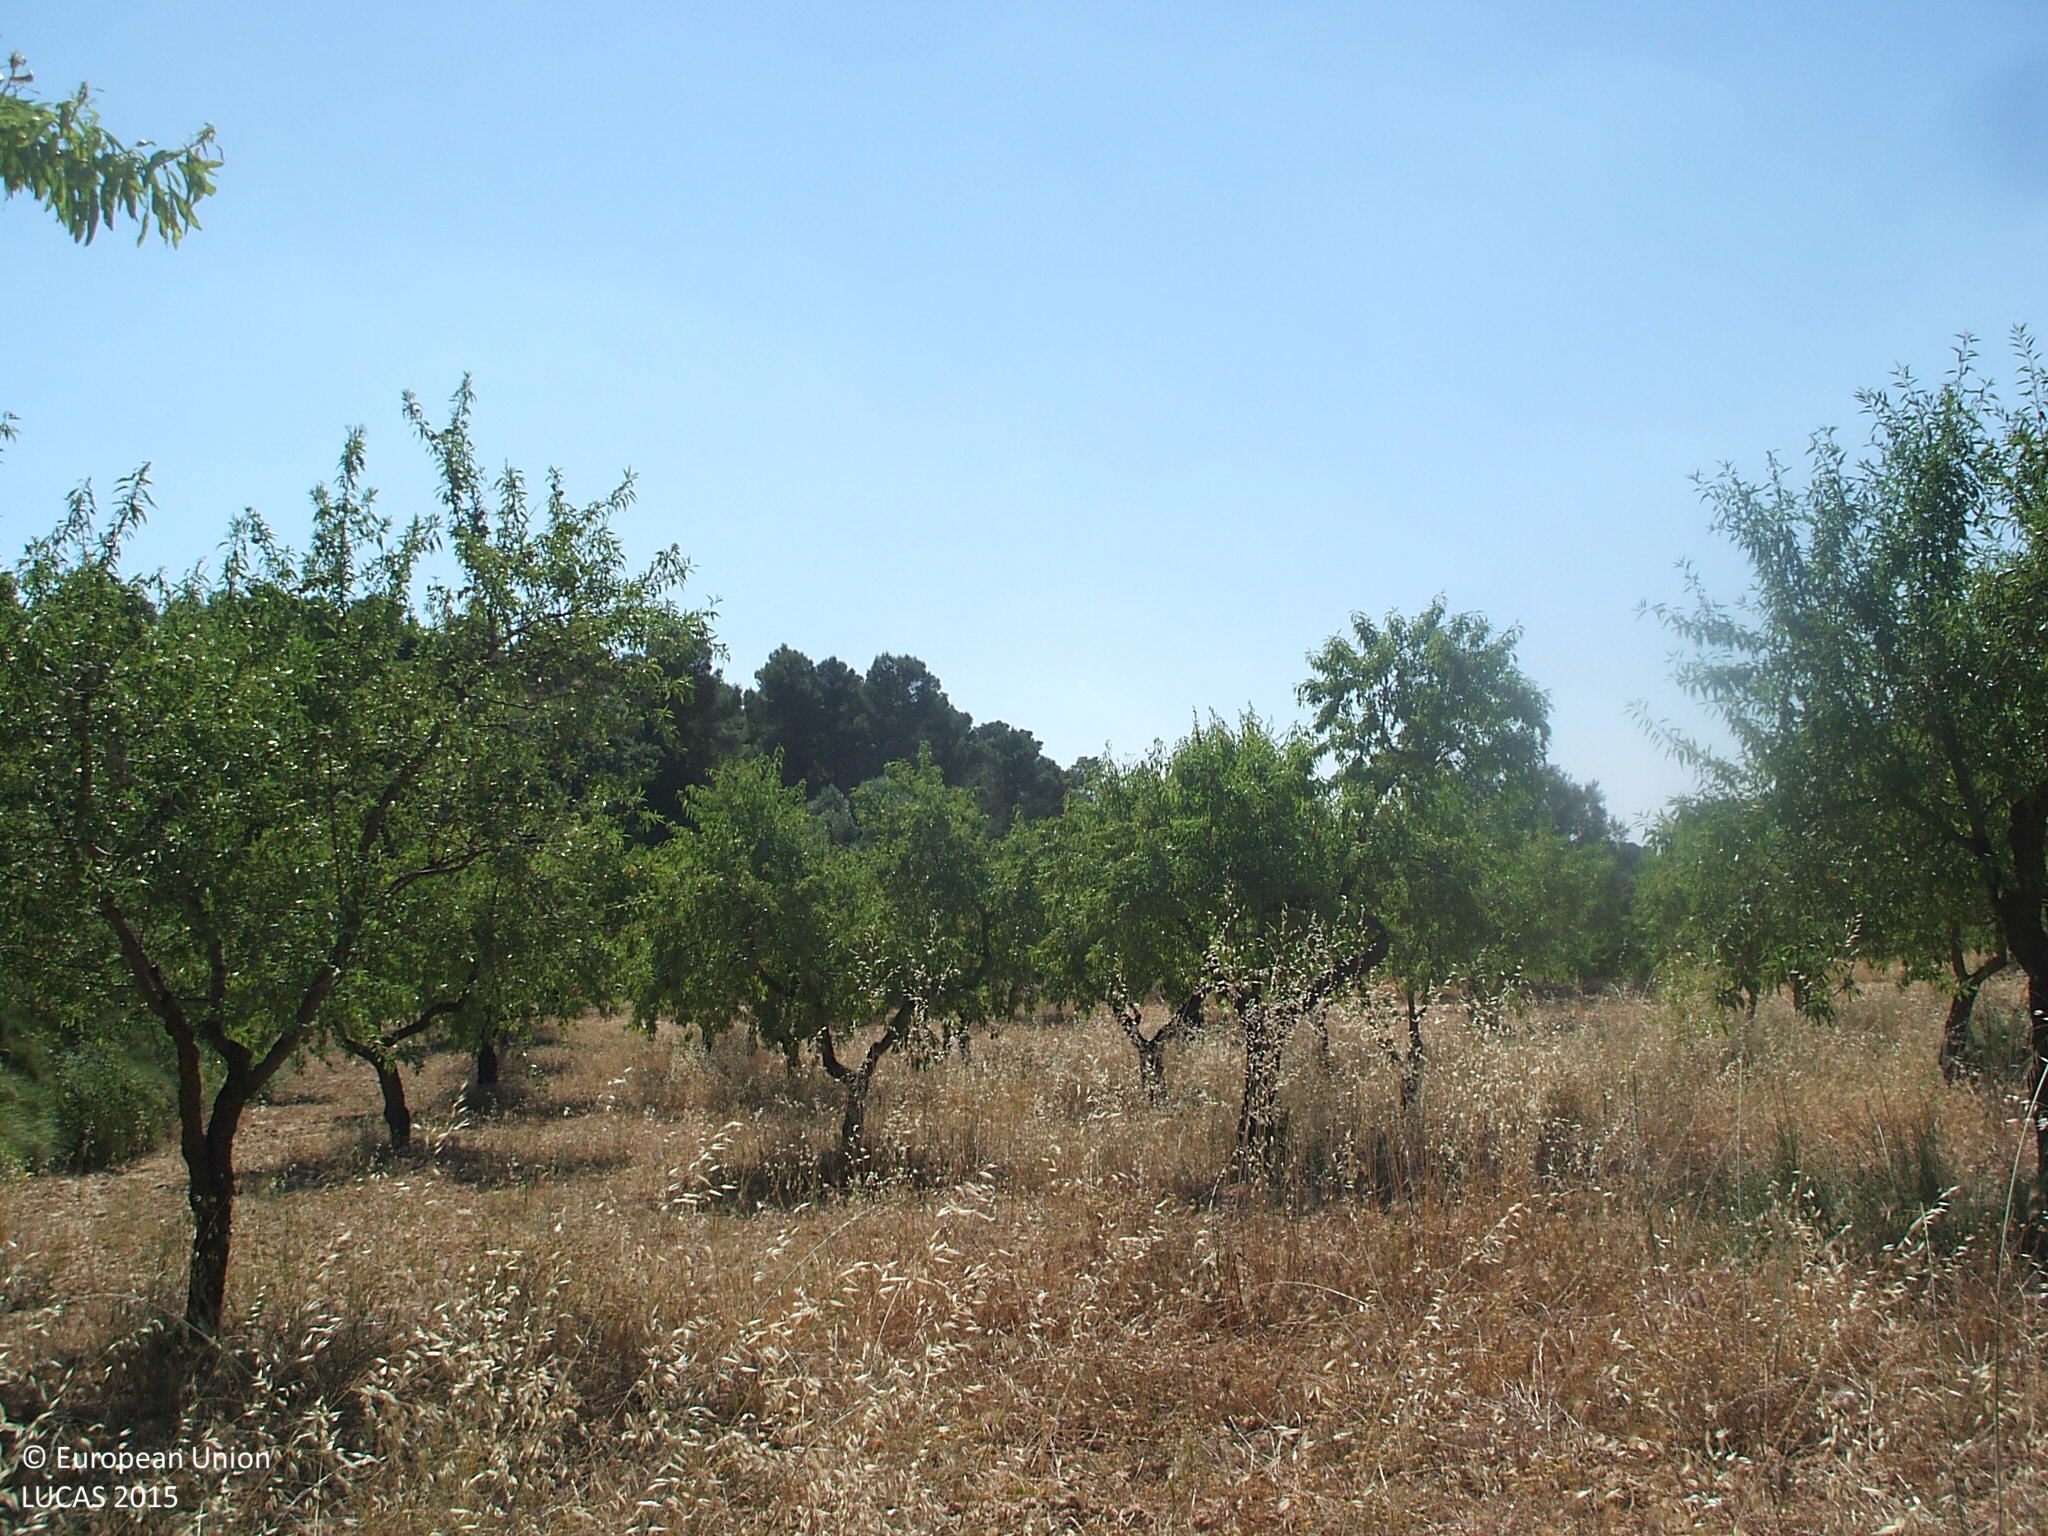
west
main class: Cropland
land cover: Nuts trees
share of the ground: 25 - 50 %
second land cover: Spontaneously vegetated surfaces
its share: > 75 %
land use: Agriculture (excluding fallow land and kitchen gardens)
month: June
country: ES
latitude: 40.9880
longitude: -0.0544
